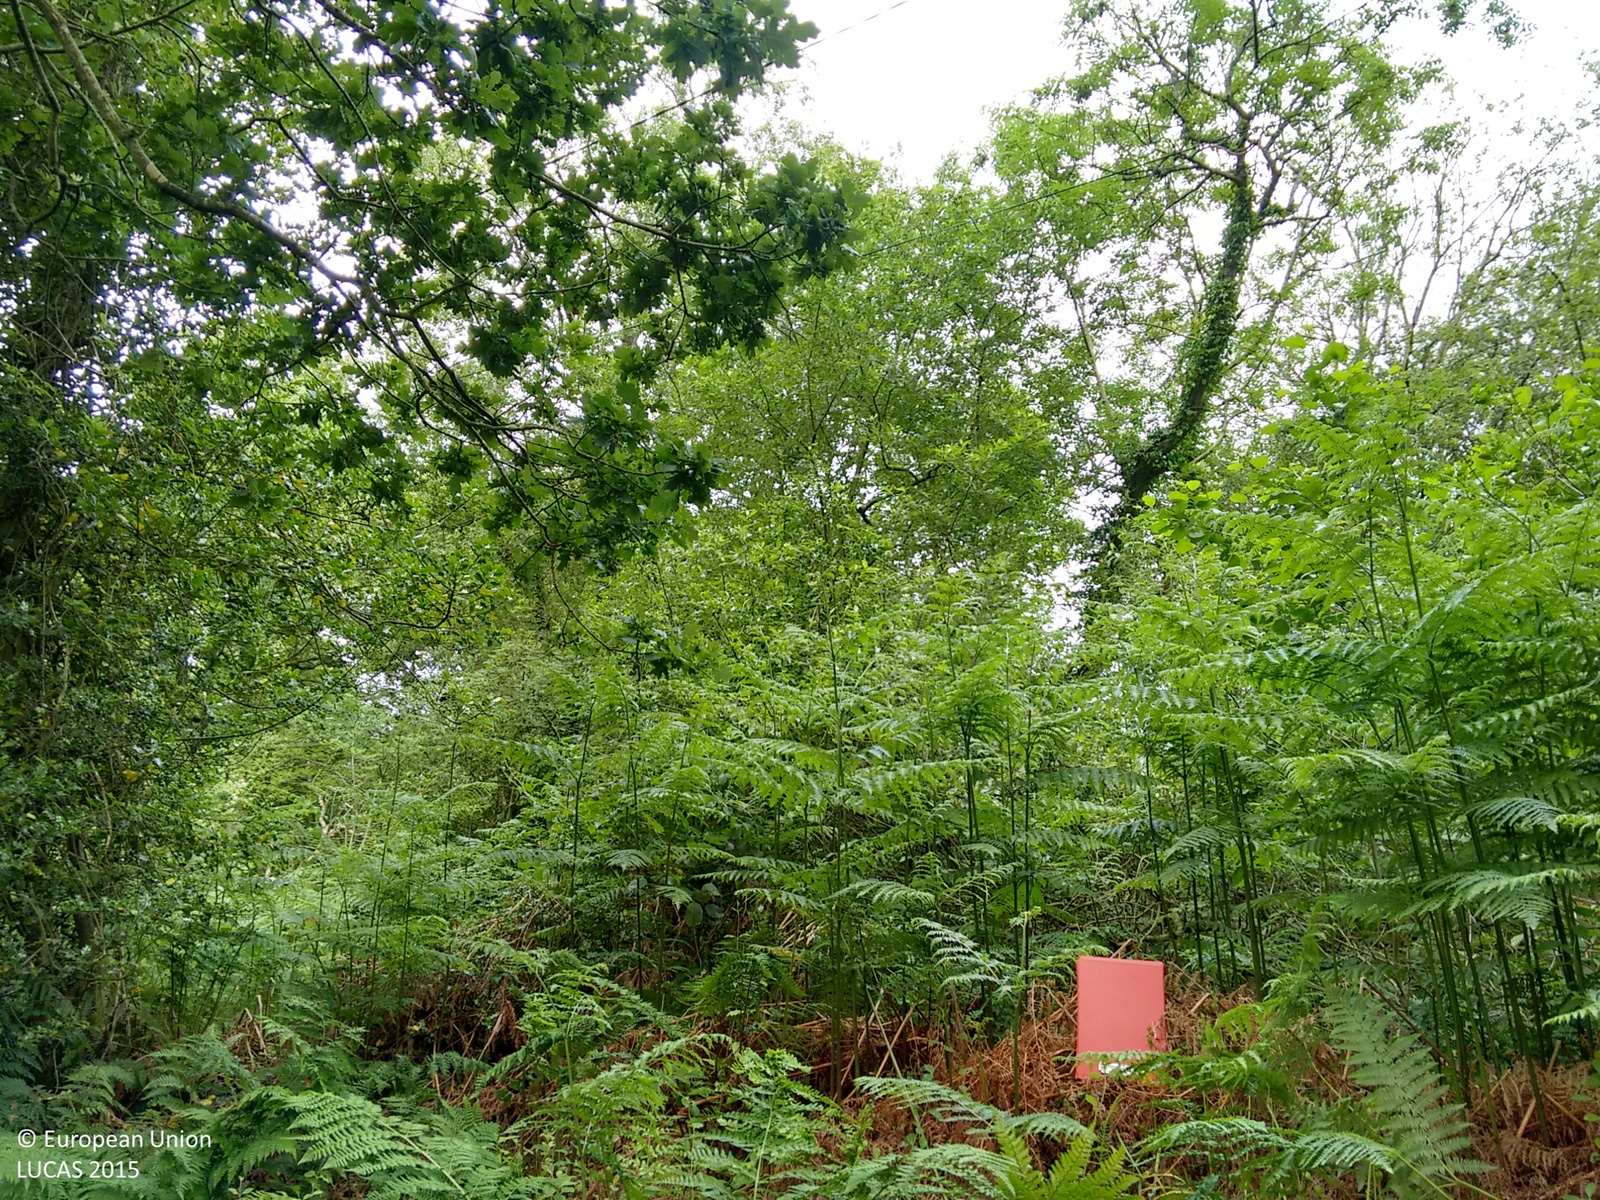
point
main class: Woodland
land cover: Broadleaved woodland
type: acidophilous oak and oak-birch forest
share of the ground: > 75 %
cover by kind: broadleaved forest trees 100 %
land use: Semi-natural and natural areas not in use
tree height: > 5 m
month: July
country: GB
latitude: 54.9735
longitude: -3.5325
